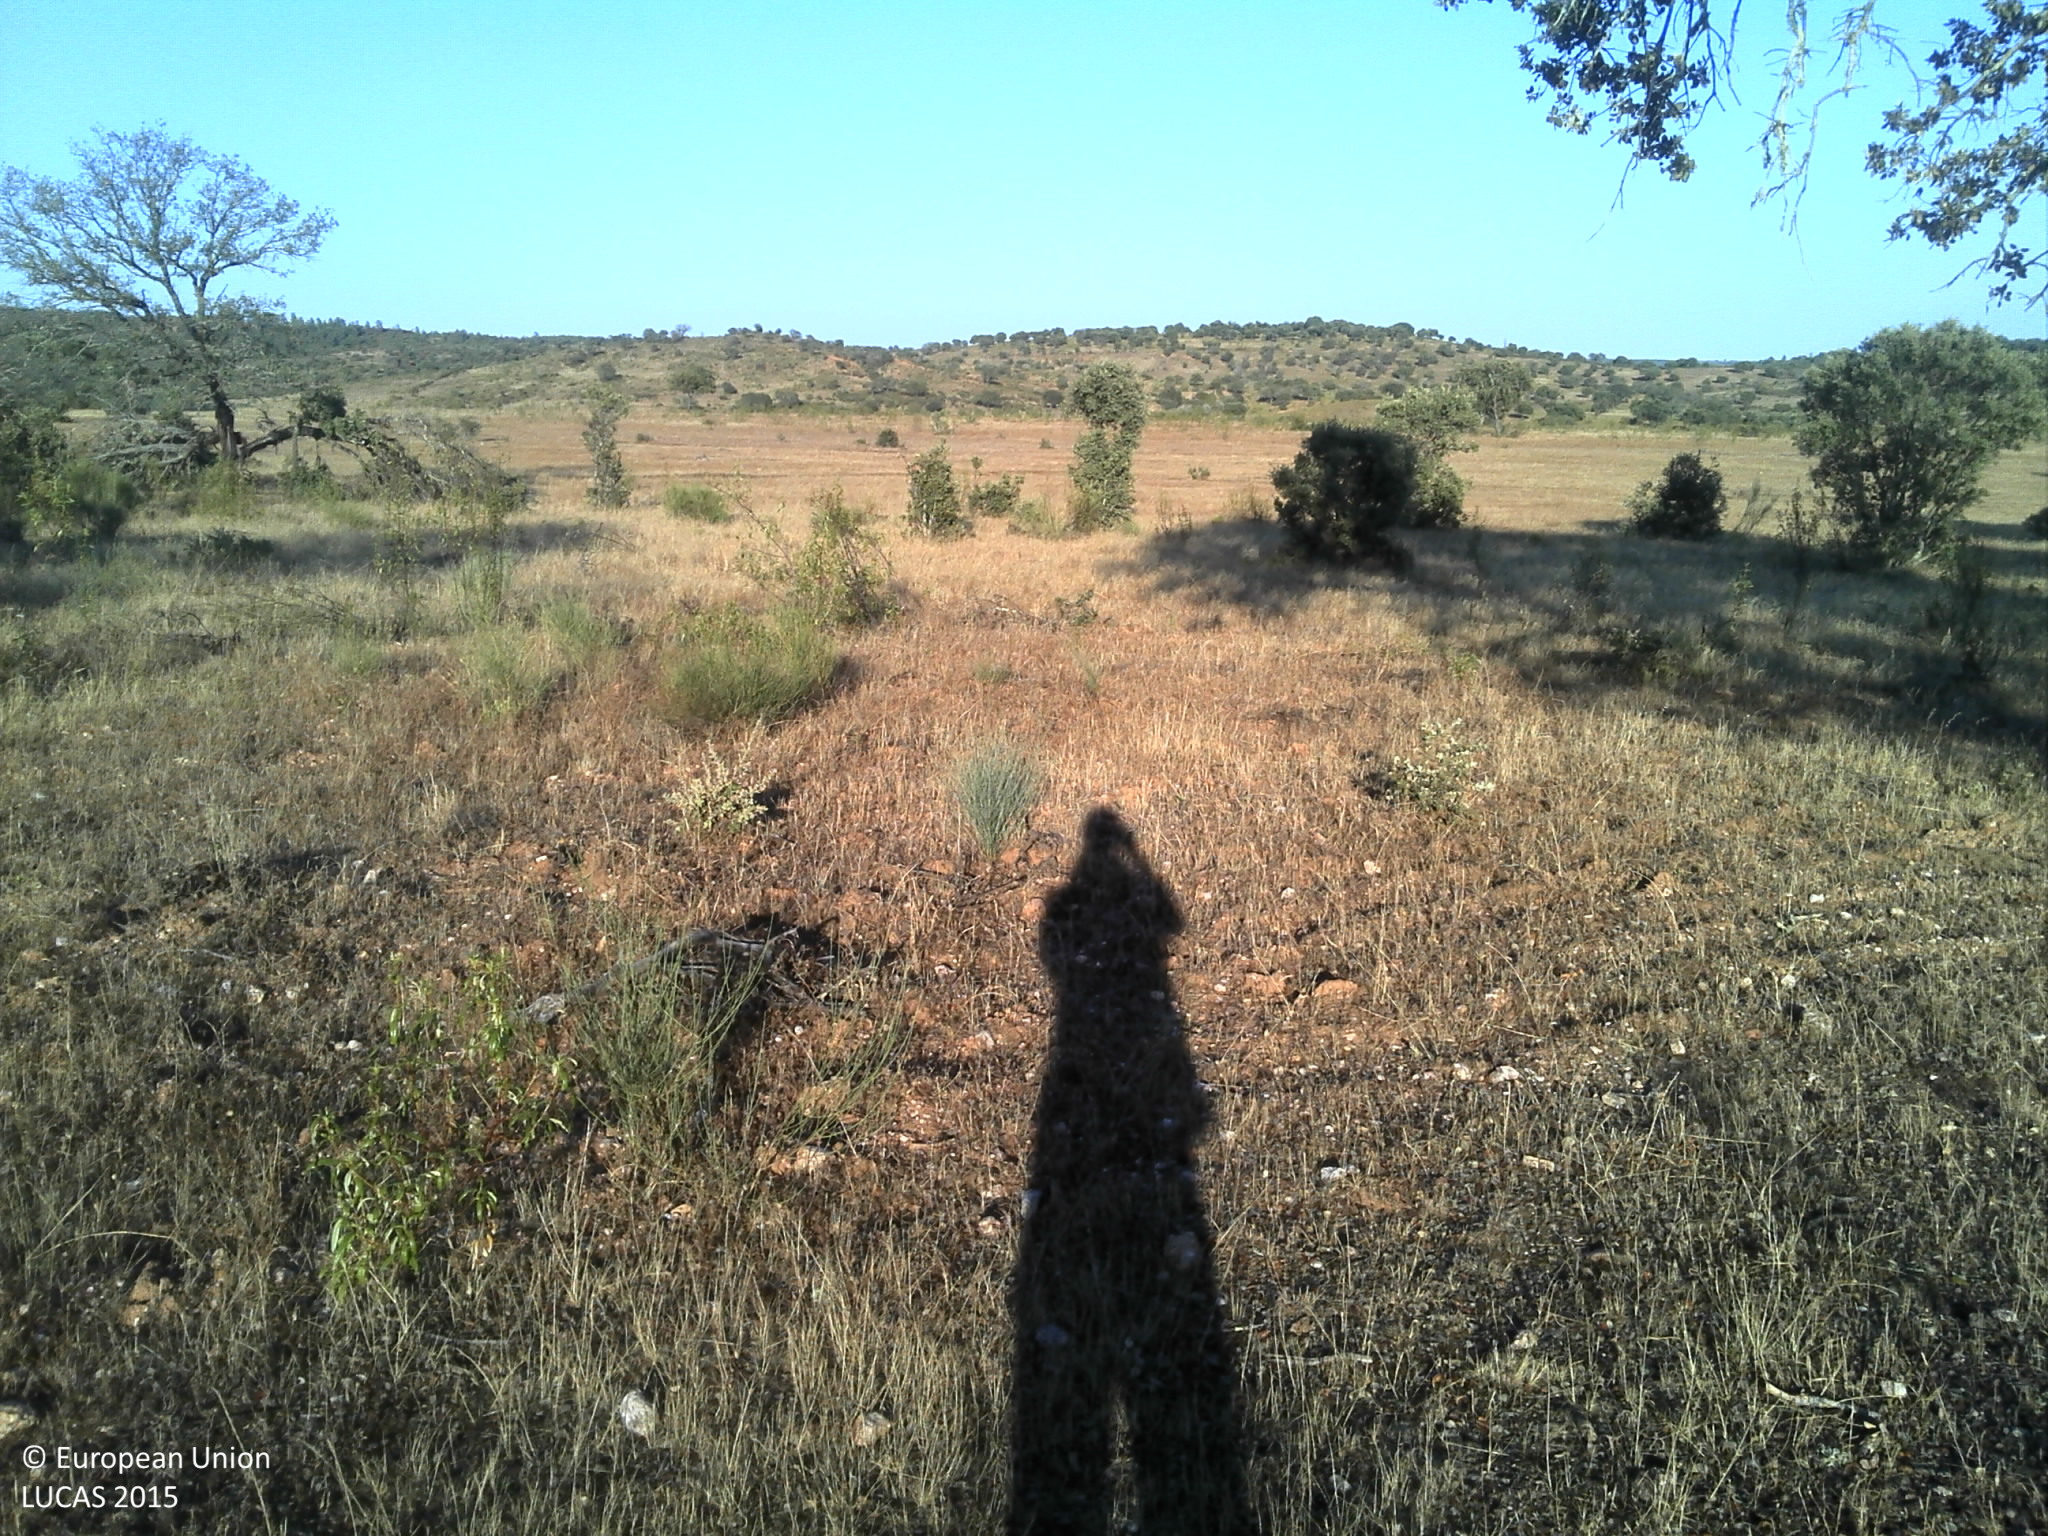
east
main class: Grassland
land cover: Grassland with sparse tree/shrub cover
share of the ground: 25 - 50 %
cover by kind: unconsolidated bare surface 45 %, herbaceous plants 40 %, broadleaved forest trees 5 %, shrubs 5 %
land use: Agriculture (excluding fallow land and kitchen gardens)
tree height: > 5 m
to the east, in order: Grassland with sparse tree/shrub cover; Grassland without tree/shrub cover; Tracks; Grassland without tree/shrub cover; Single bushes/trees; Grassland without tree/shrub cover
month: June
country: PT
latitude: 39.9388
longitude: -7.0719
